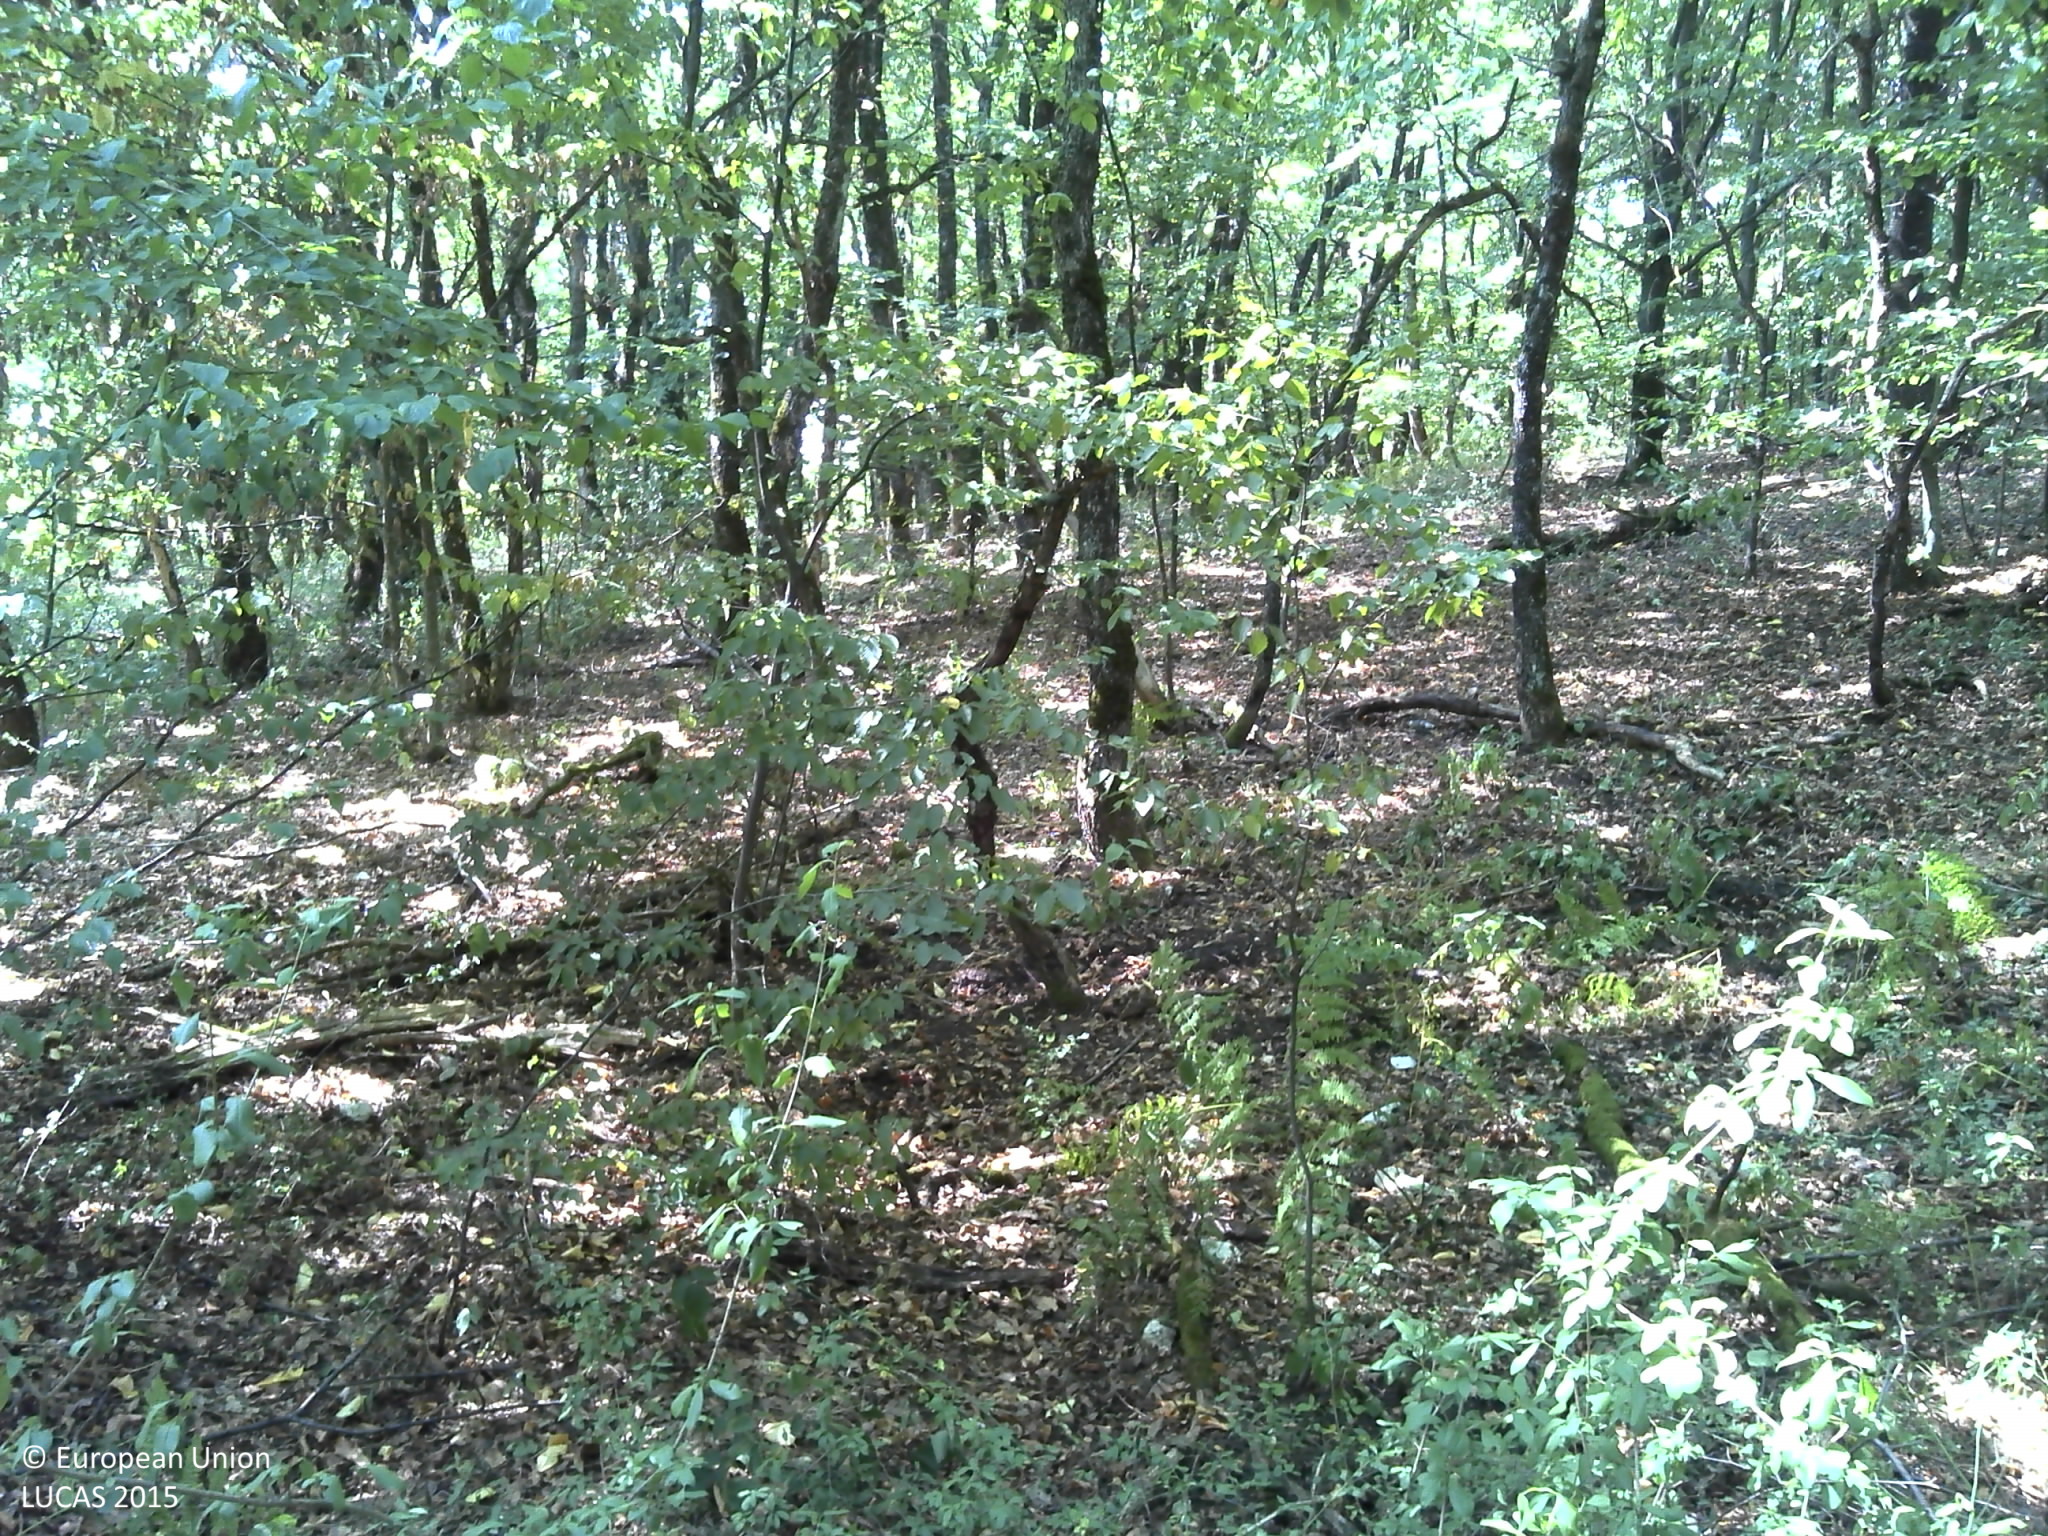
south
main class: Woodland
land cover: Broadleaved woodland
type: beech forest
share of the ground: > 75 %
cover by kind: broadleaved forest trees 100 %
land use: Forestry
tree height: > 5 m
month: August
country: HR
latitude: 45.5723
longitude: 17.3693
